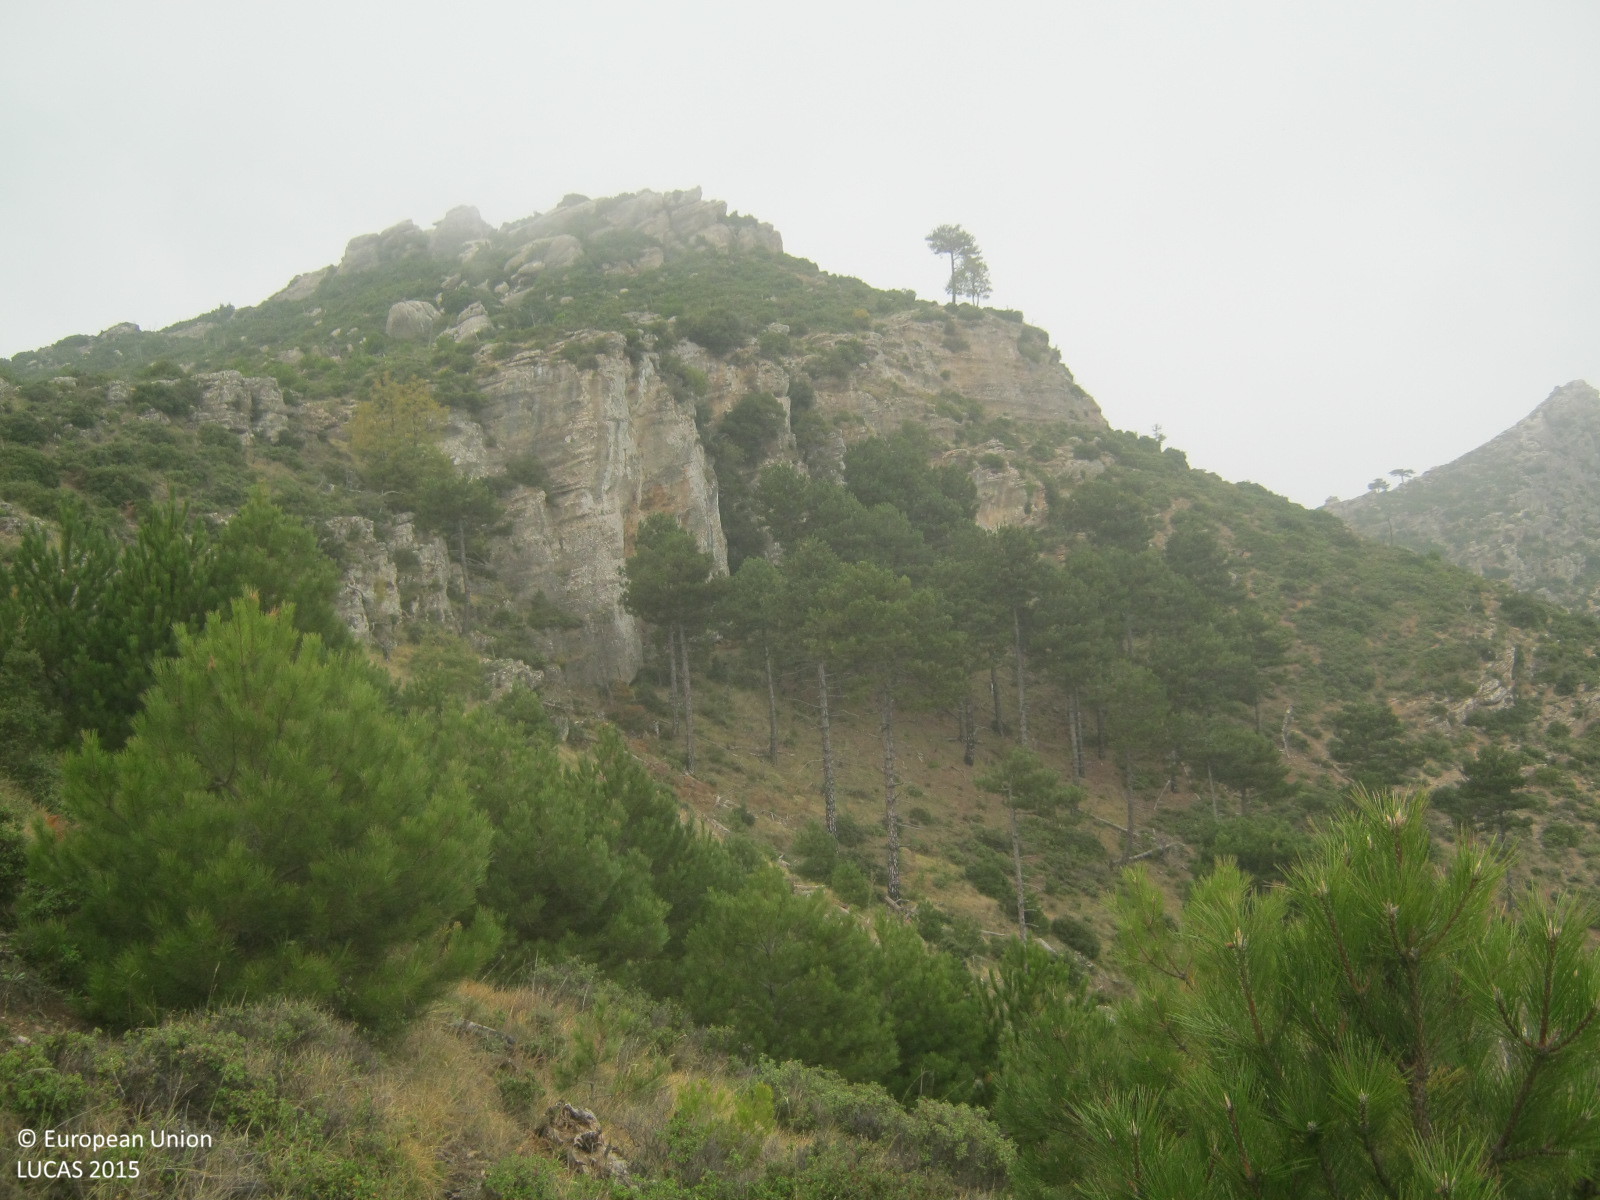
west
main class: Shrubland
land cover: Shrubland with sparse tree cover
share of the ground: 50 - 75 %
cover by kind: shrubs 65 %, unconsolidated bare surface 20 %, herbaceous plants 10 %, coniferous forest trees 5 %
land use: Semi-natural and natural areas not in use
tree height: < 5 m
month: October
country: GR
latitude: 38.0619
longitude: 22.4503
